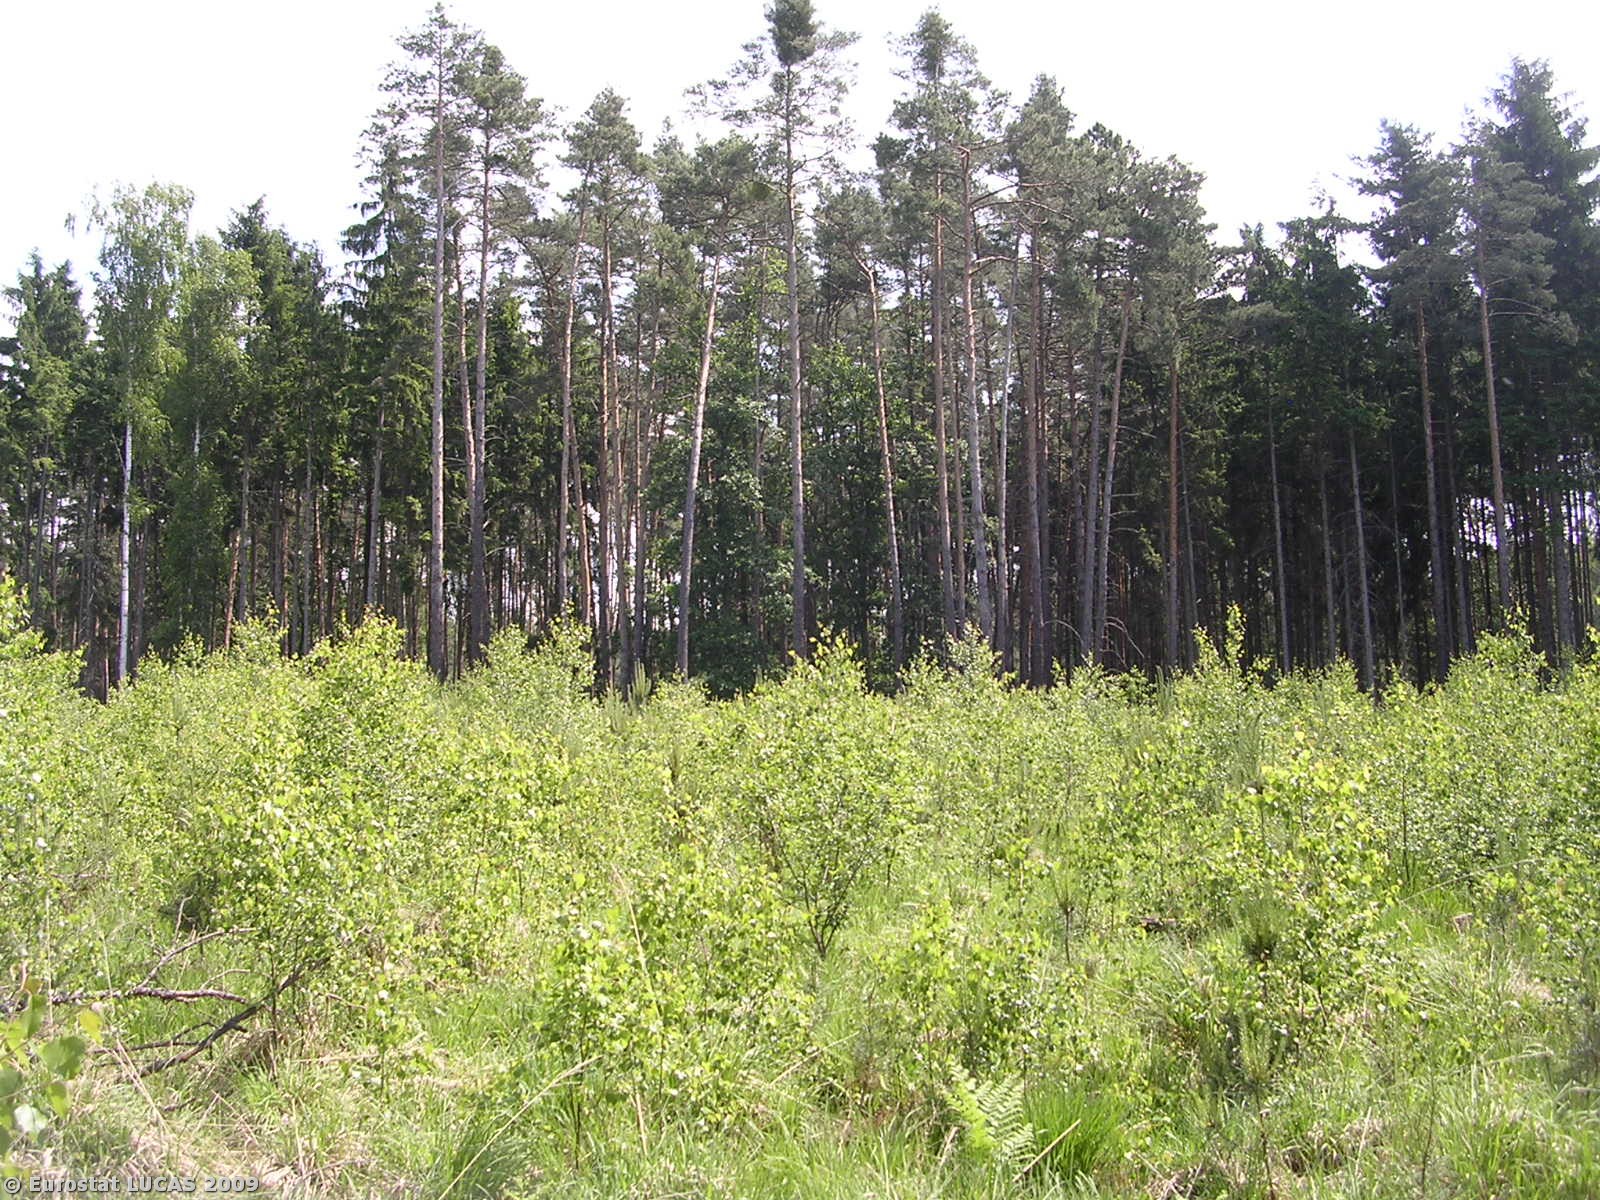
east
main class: Woodland
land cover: Mixed woodland
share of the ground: 50 - 75 %
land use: Forestry
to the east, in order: Mixed woodland; Broadleaved woodland; Coniferous woodland; Tracks; Coniferous woodland; Grassland with sparse tree/shrub cover; Mixed woodland; Coniferous woodland
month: May
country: CZ
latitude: 50.2865
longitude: 14.6757
